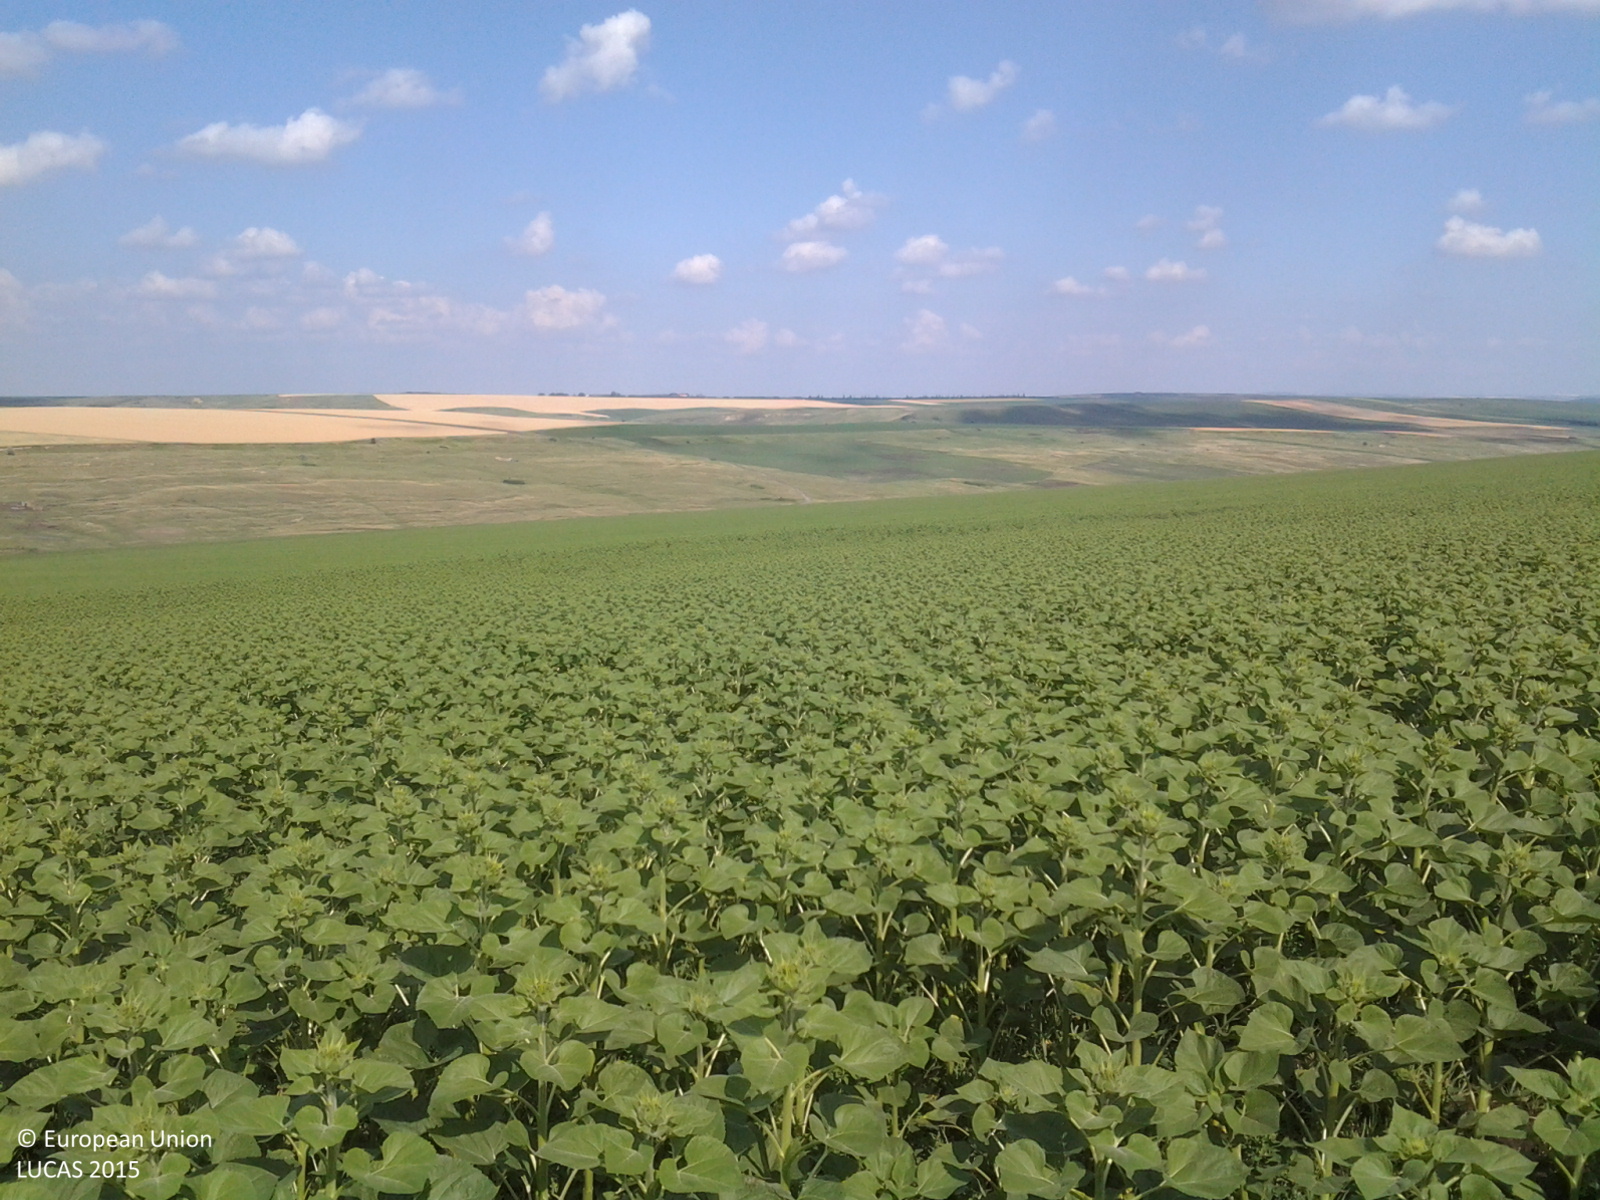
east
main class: Cropland
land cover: Sunflower
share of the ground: 50 - 75 %
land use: Agriculture (excluding fallow land and kitchen gardens)
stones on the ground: < 10 %
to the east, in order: Sunflower; Grass margins; Tracks; Grass margins; Sunflower
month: June
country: RO
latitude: 47.5233
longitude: 27.0651
